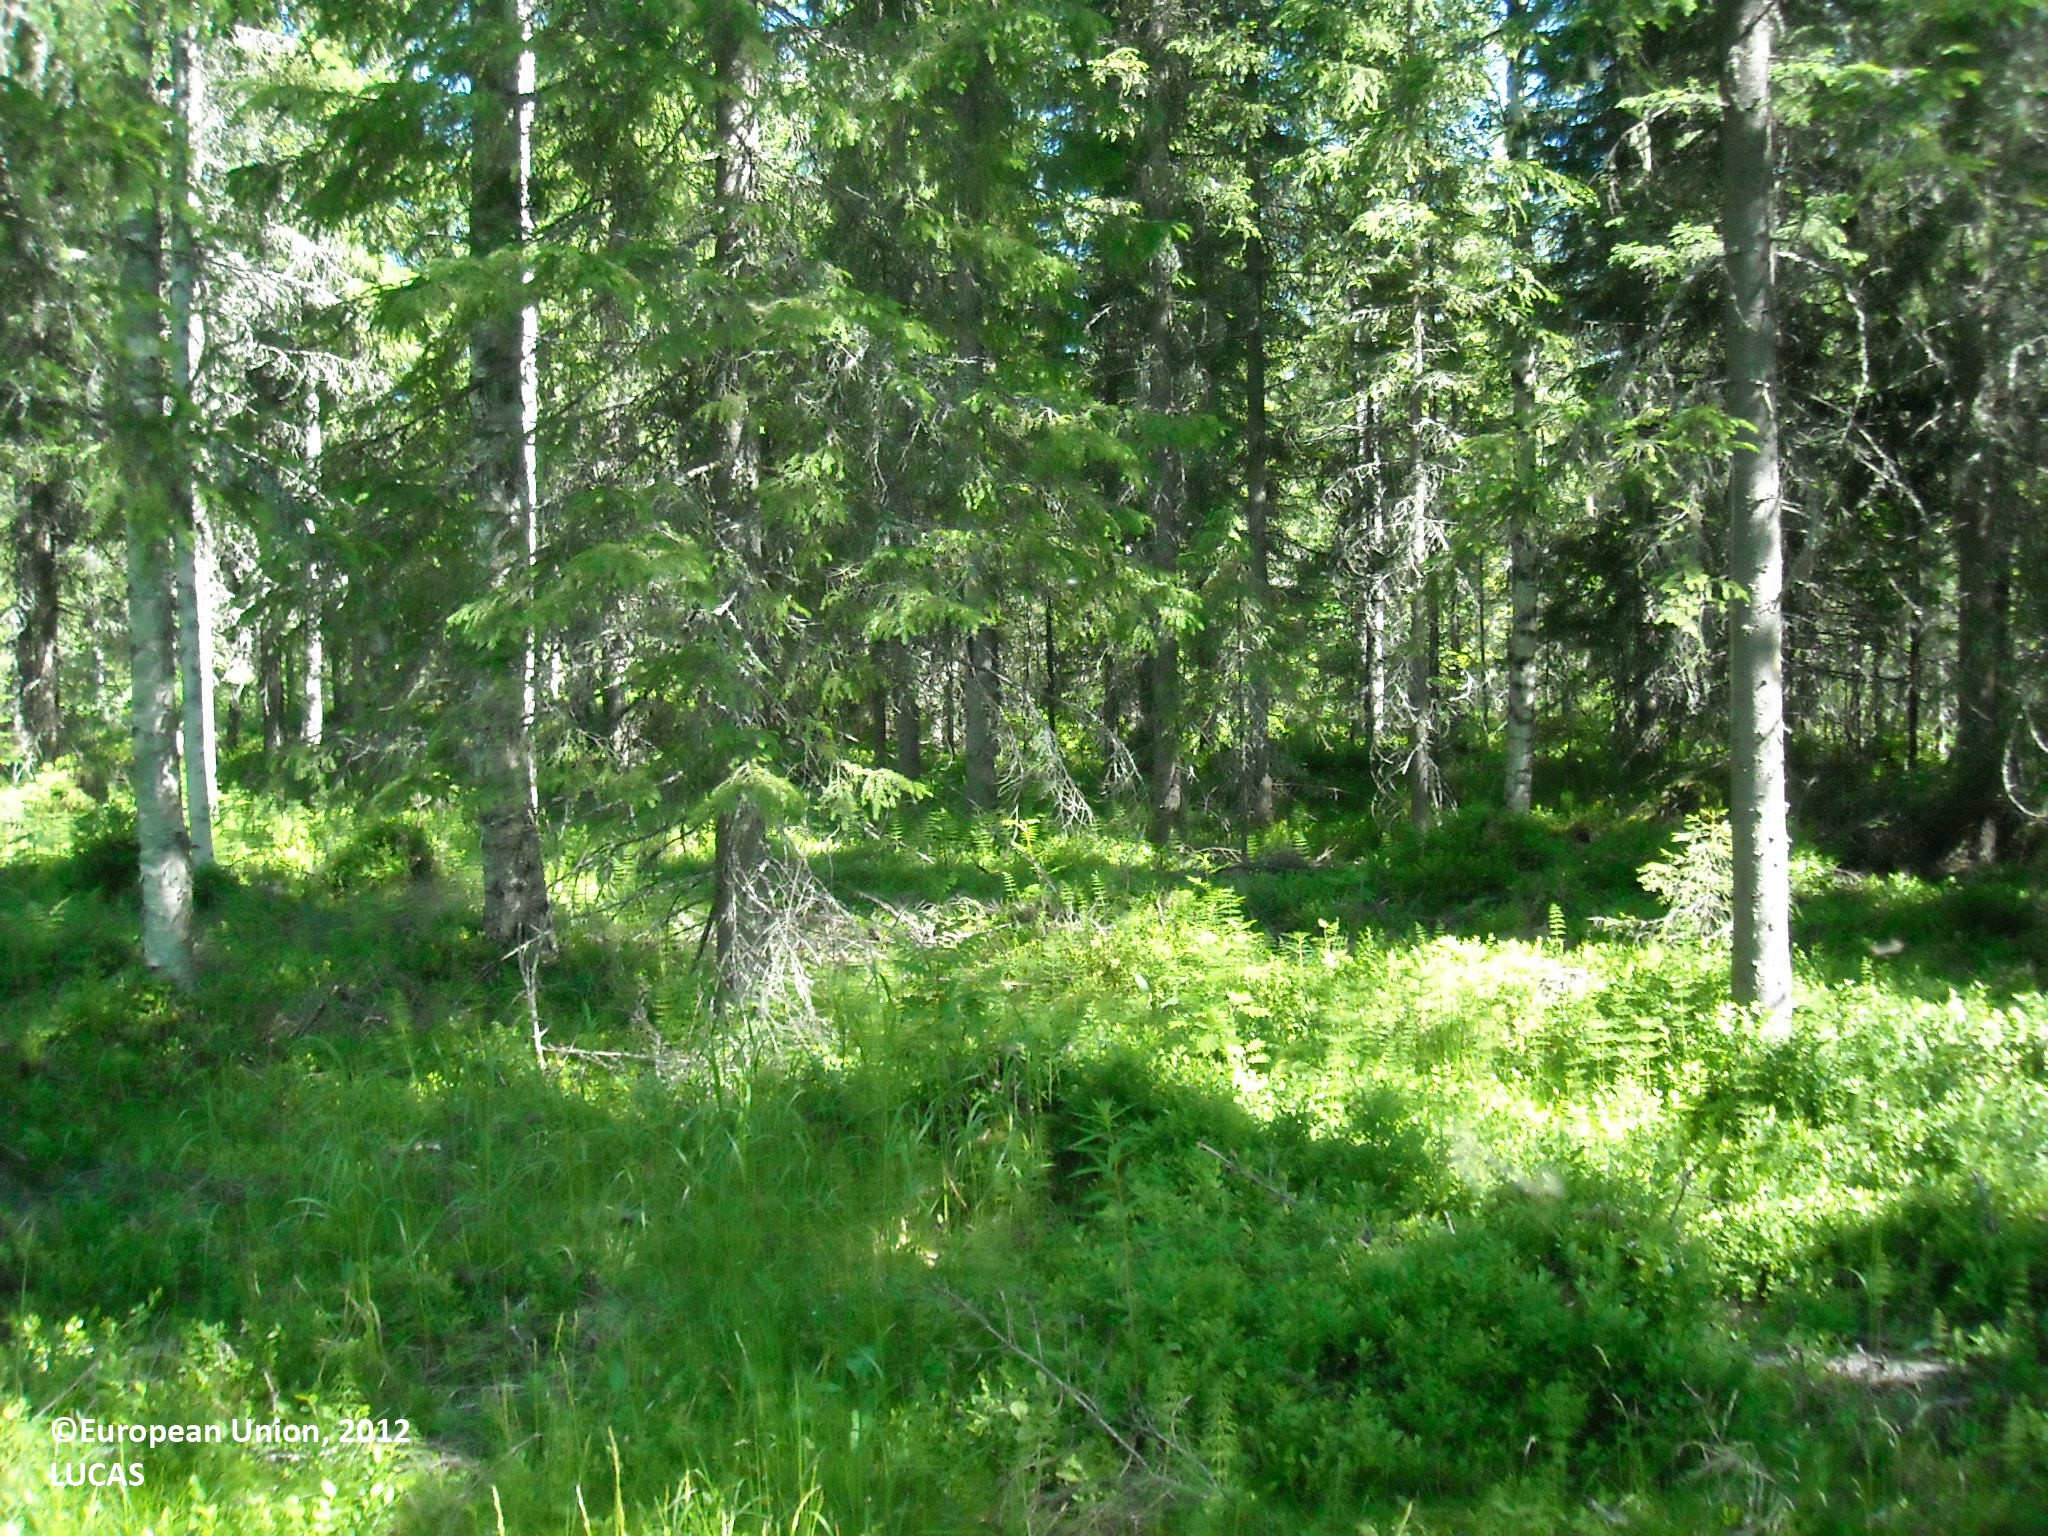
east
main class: Woodland
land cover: Spruce dominated mixed woodland
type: boreal forest
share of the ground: > 75 %
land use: Forestry
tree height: > 5 m
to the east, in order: Spruce dominated mixed woodland; Other mixed woodland; Pine dominated coniferous woodland
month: July
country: FI
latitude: 64.6761
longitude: 27.8576
